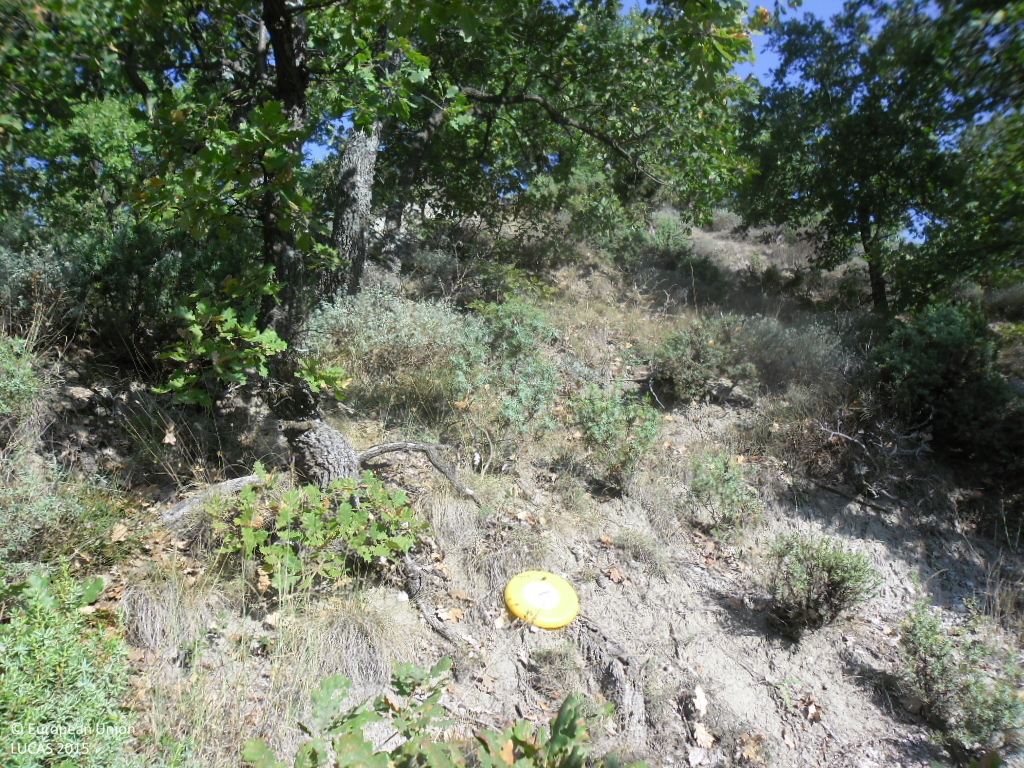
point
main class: Woodland
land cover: Broadleaved woodland
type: thermophilous deciduous forest
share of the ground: > 75 %
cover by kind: broadleaved forest trees 95 %, unconsolidated bare surface 5 %
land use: Forestry
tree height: > 5 m
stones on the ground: < 10 %
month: September
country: BG
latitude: 41.8665
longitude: 23.1432
